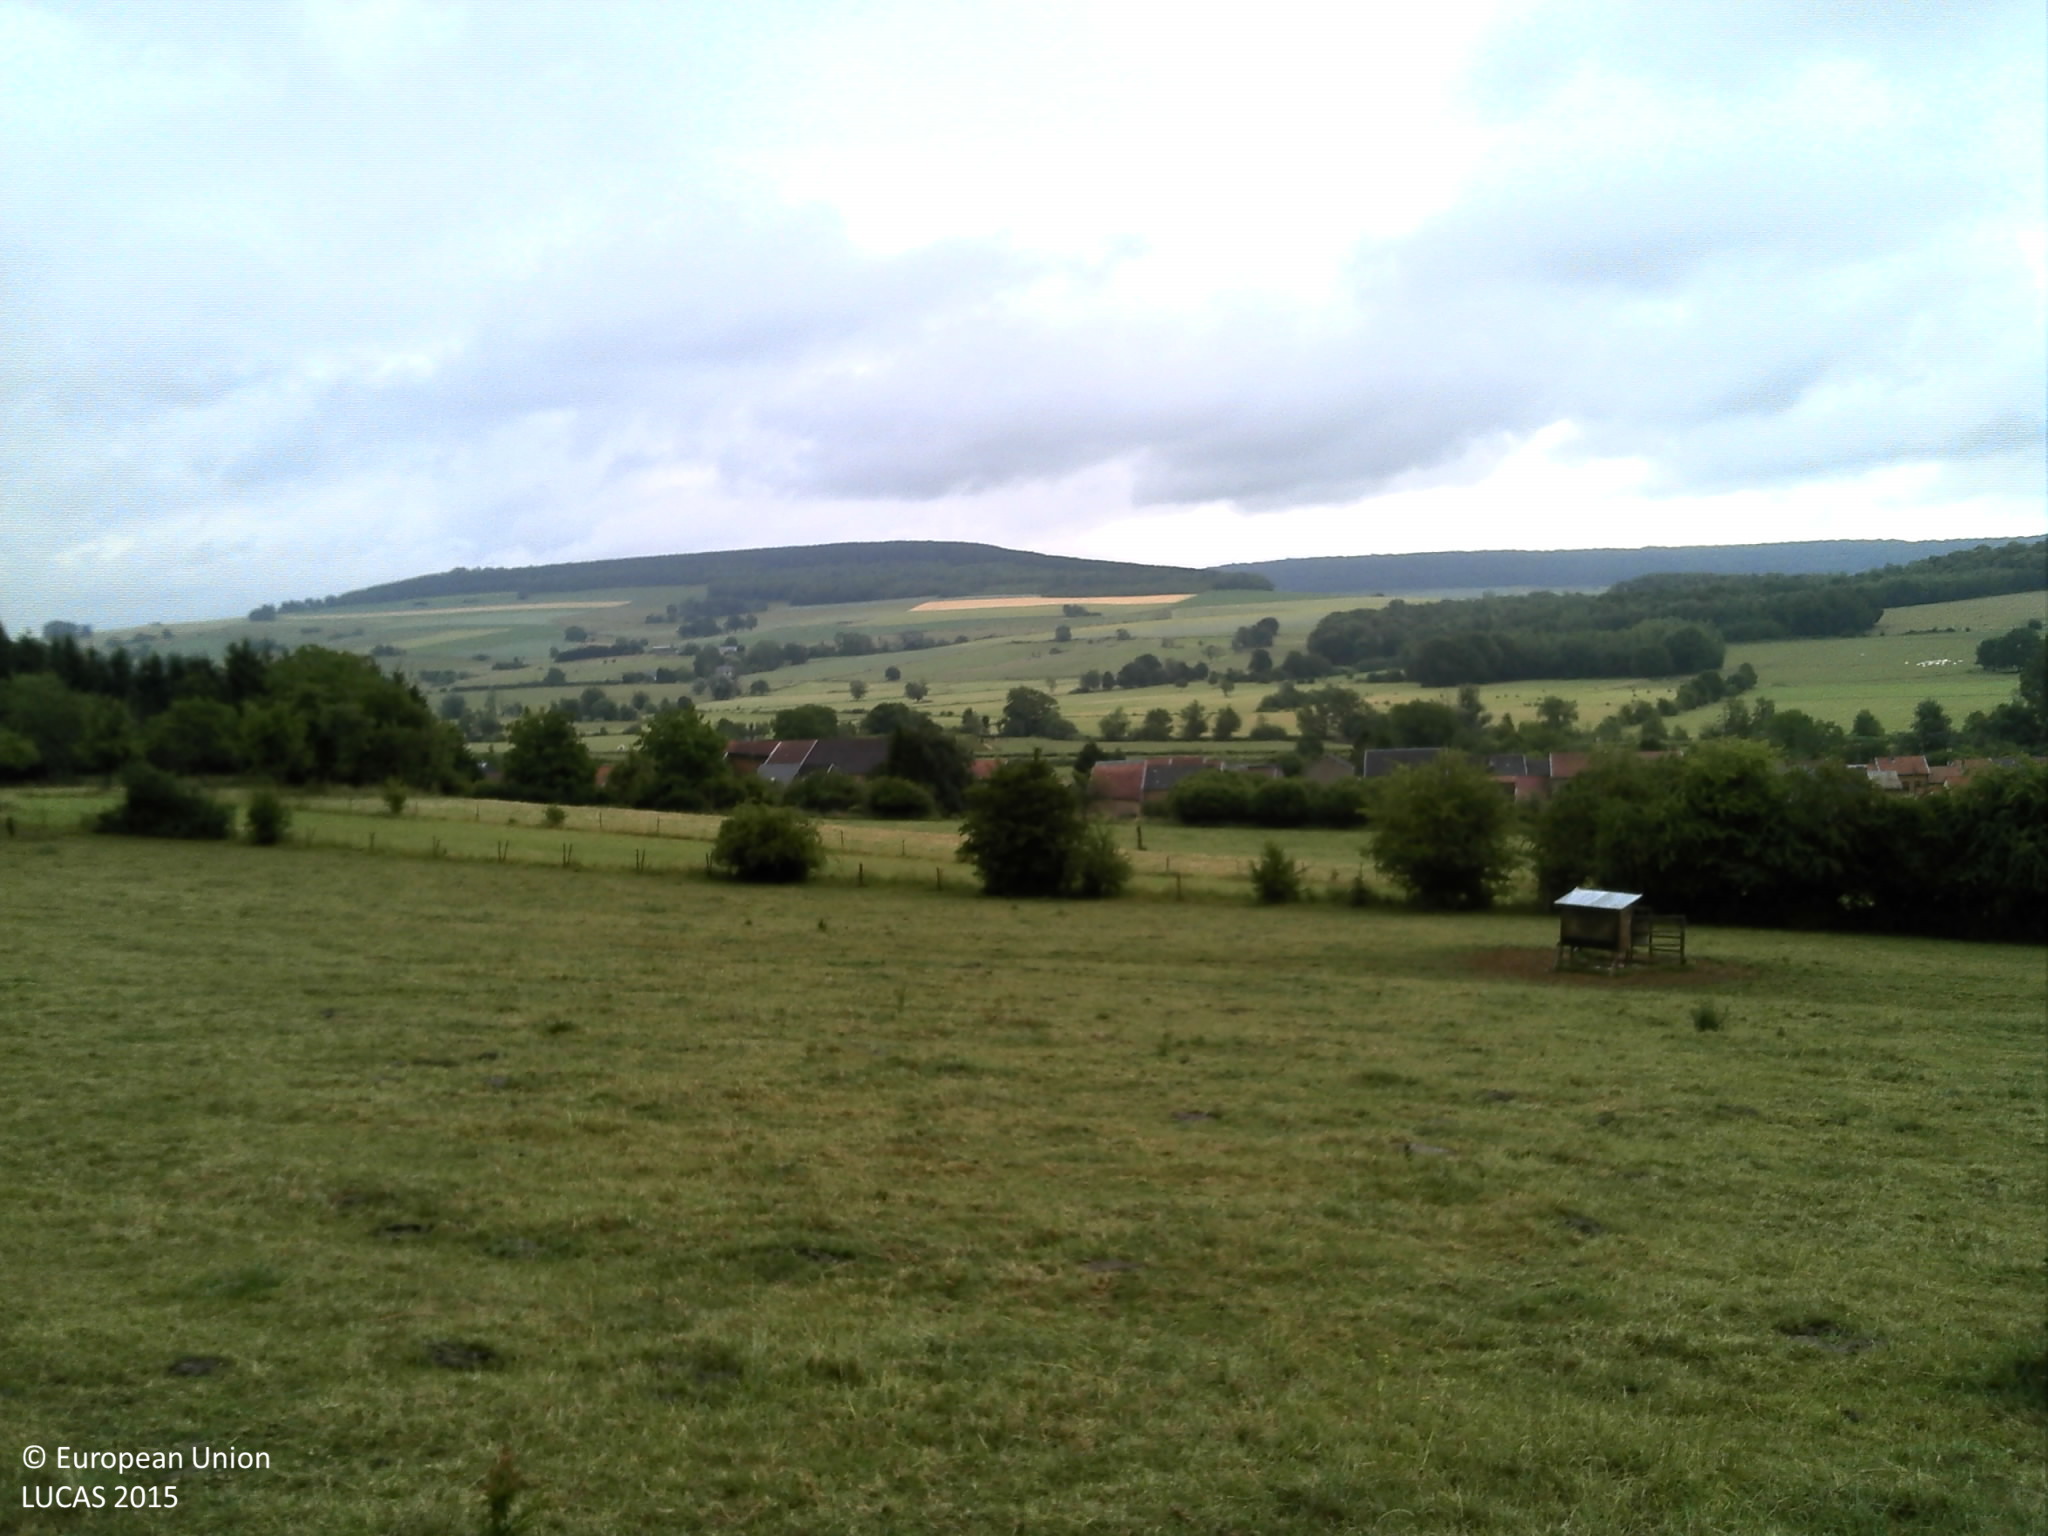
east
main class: Grassland
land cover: Grassland without tree/shrub cover
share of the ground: > 75 %
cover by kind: herbaceous plants 100 %
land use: Agriculture (excluding fallow land and kitchen gardens)
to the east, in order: Grassland without tree/shrub cover; Fences; Grass margins; Fences; Grassland without tree/shrub cover; Fences; Managed hedges; Single bushes/trees; Grassland without tree/shrub cover; Broadleaved woodland
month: June
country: FR
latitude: 49.6705
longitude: 4.8286
